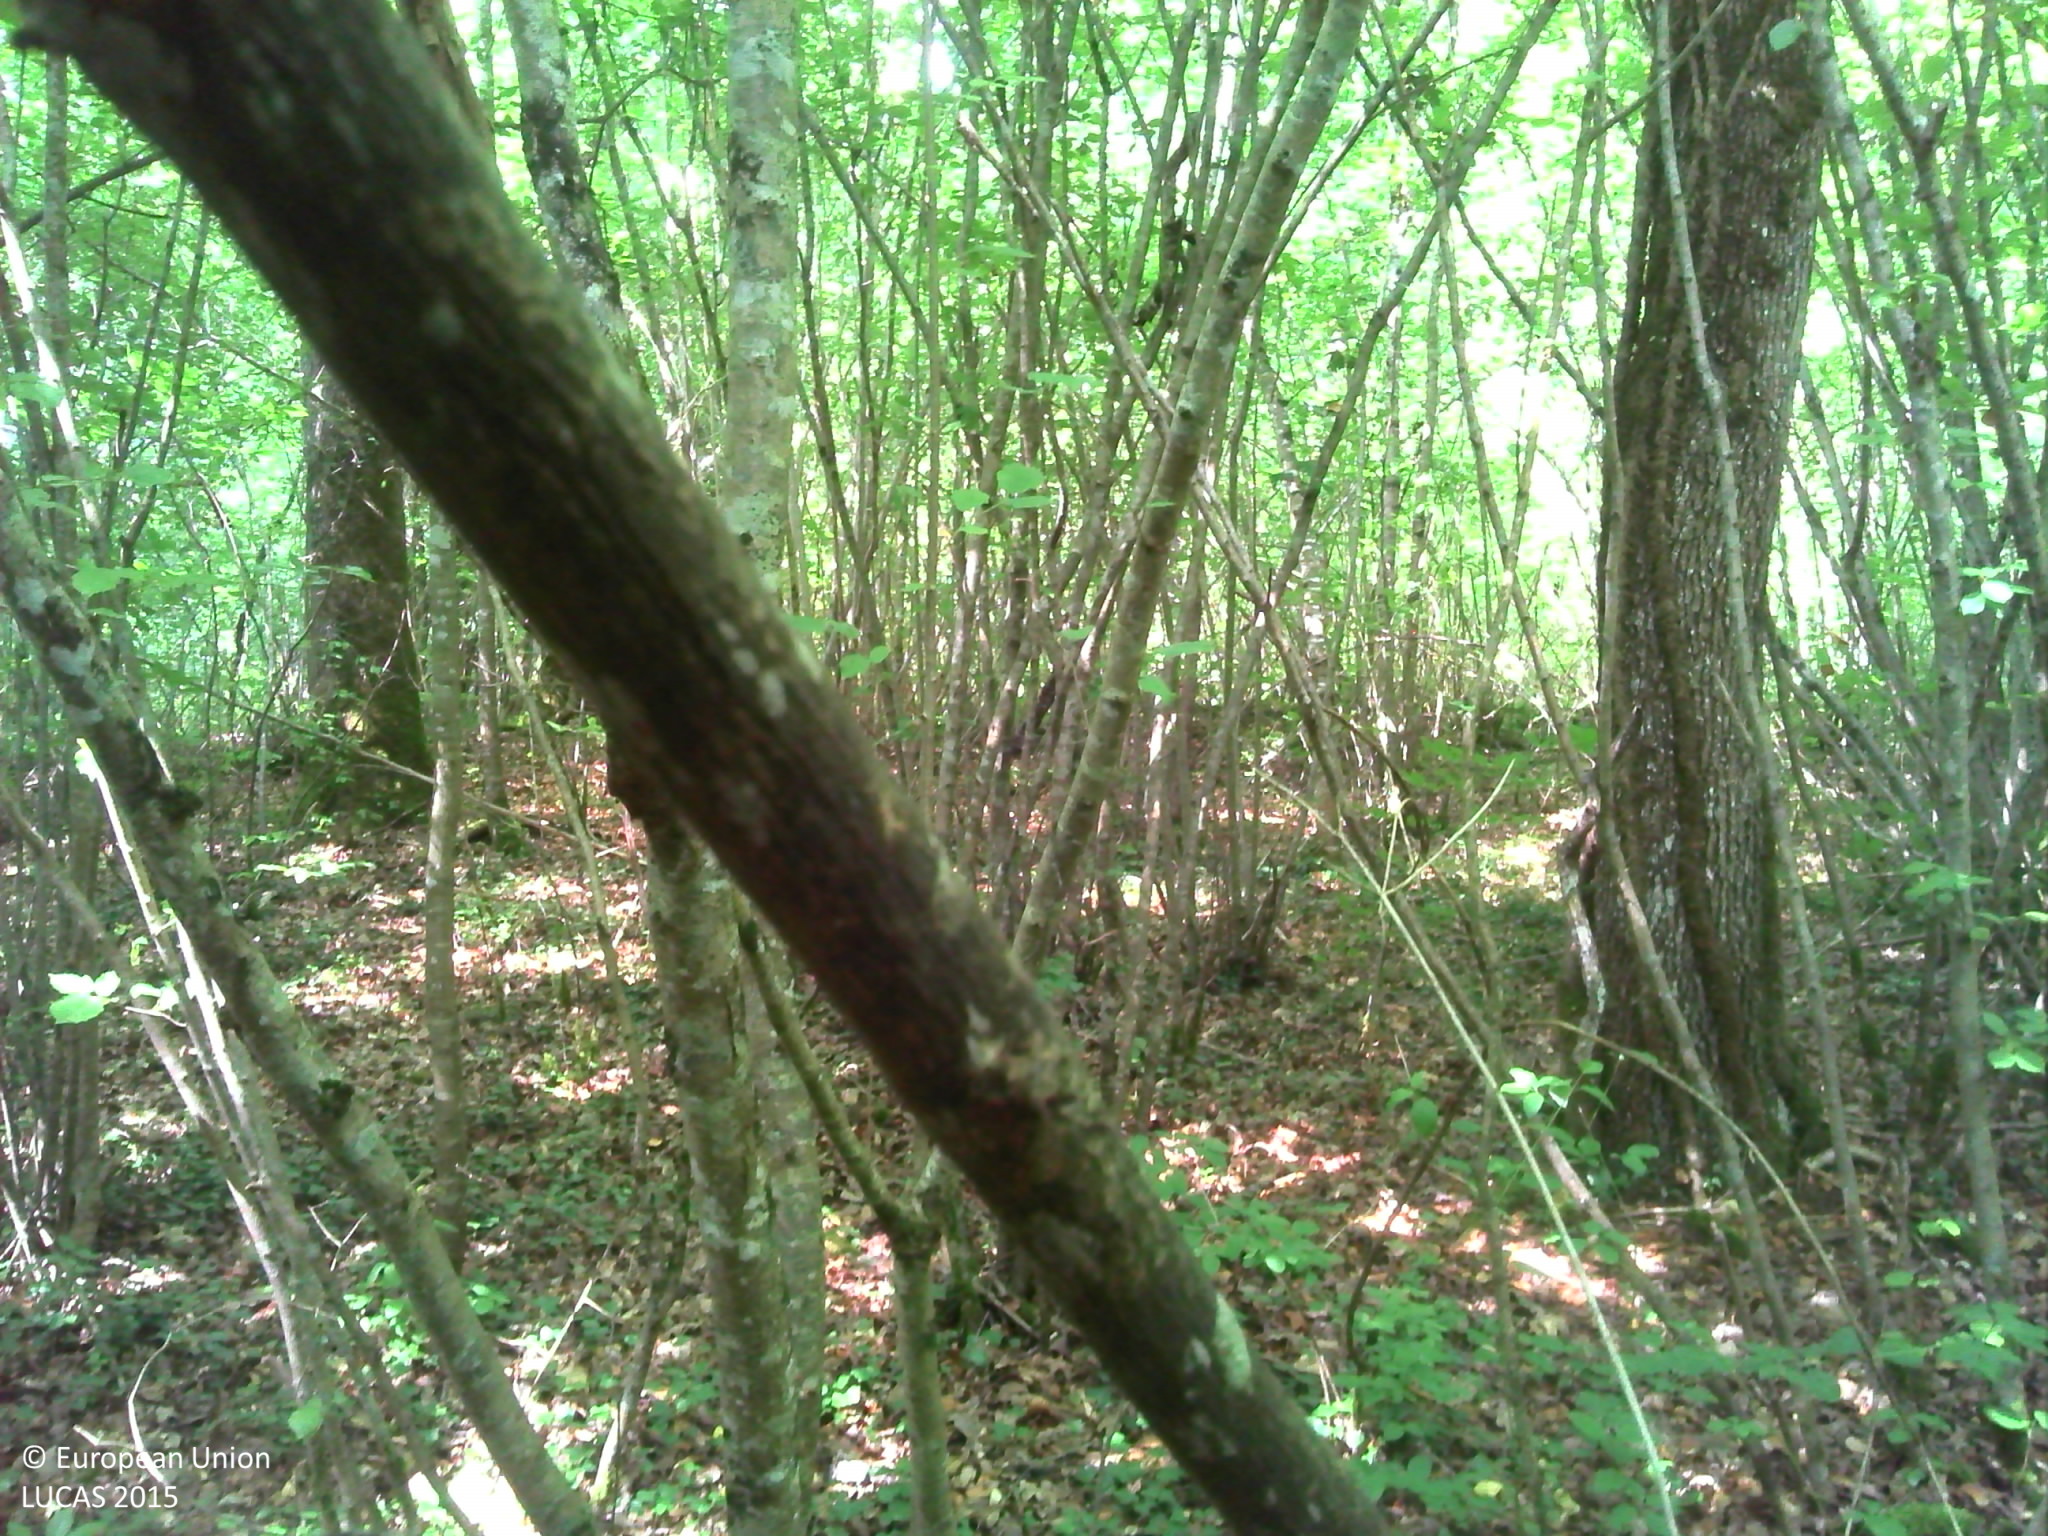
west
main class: Woodland
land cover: Broadleaved woodland
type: mesophytic deciduous forest
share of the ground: > 75 %
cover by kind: broadleaved forest trees 90 %, herbaceous plants 5 %, lichens and mosses 5 %
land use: Forestry
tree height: > 5 m
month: July
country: FR
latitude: 47.6385
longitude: 3.5673
